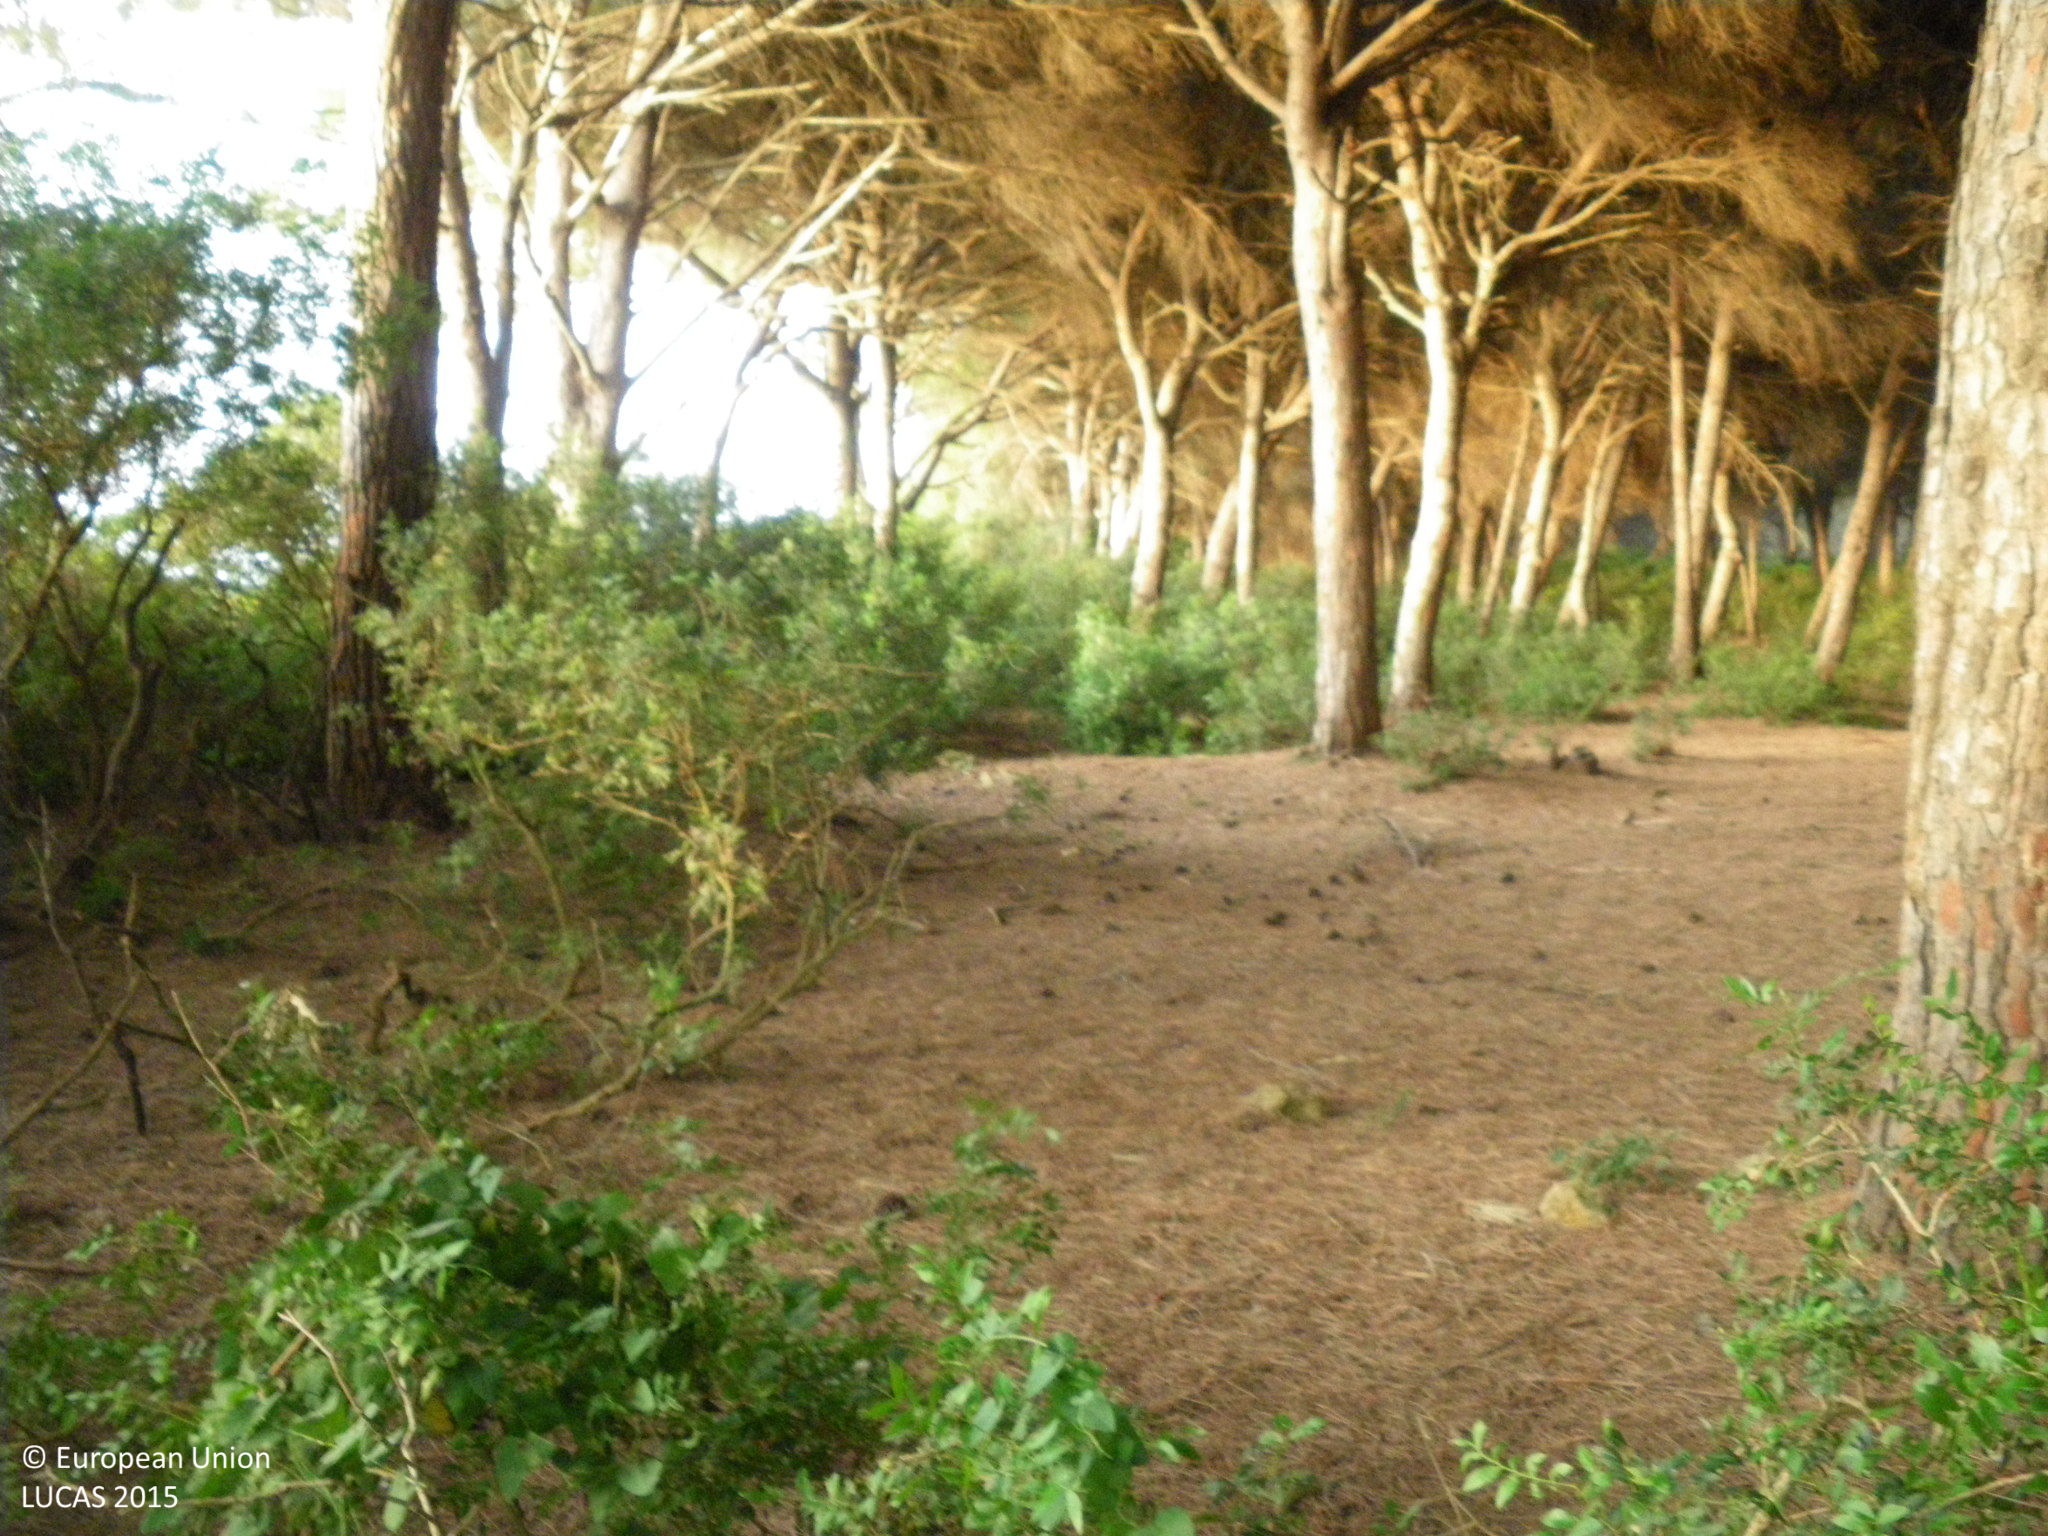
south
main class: Woodland
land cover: Pine dominated coniferous woodland
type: coniferous forest of the mediterranean region
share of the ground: > 75 %
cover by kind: coniferous forest trees 100 %
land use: Forestry
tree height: > 5 m
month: June
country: ES
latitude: 36.5492
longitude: -6.1070
